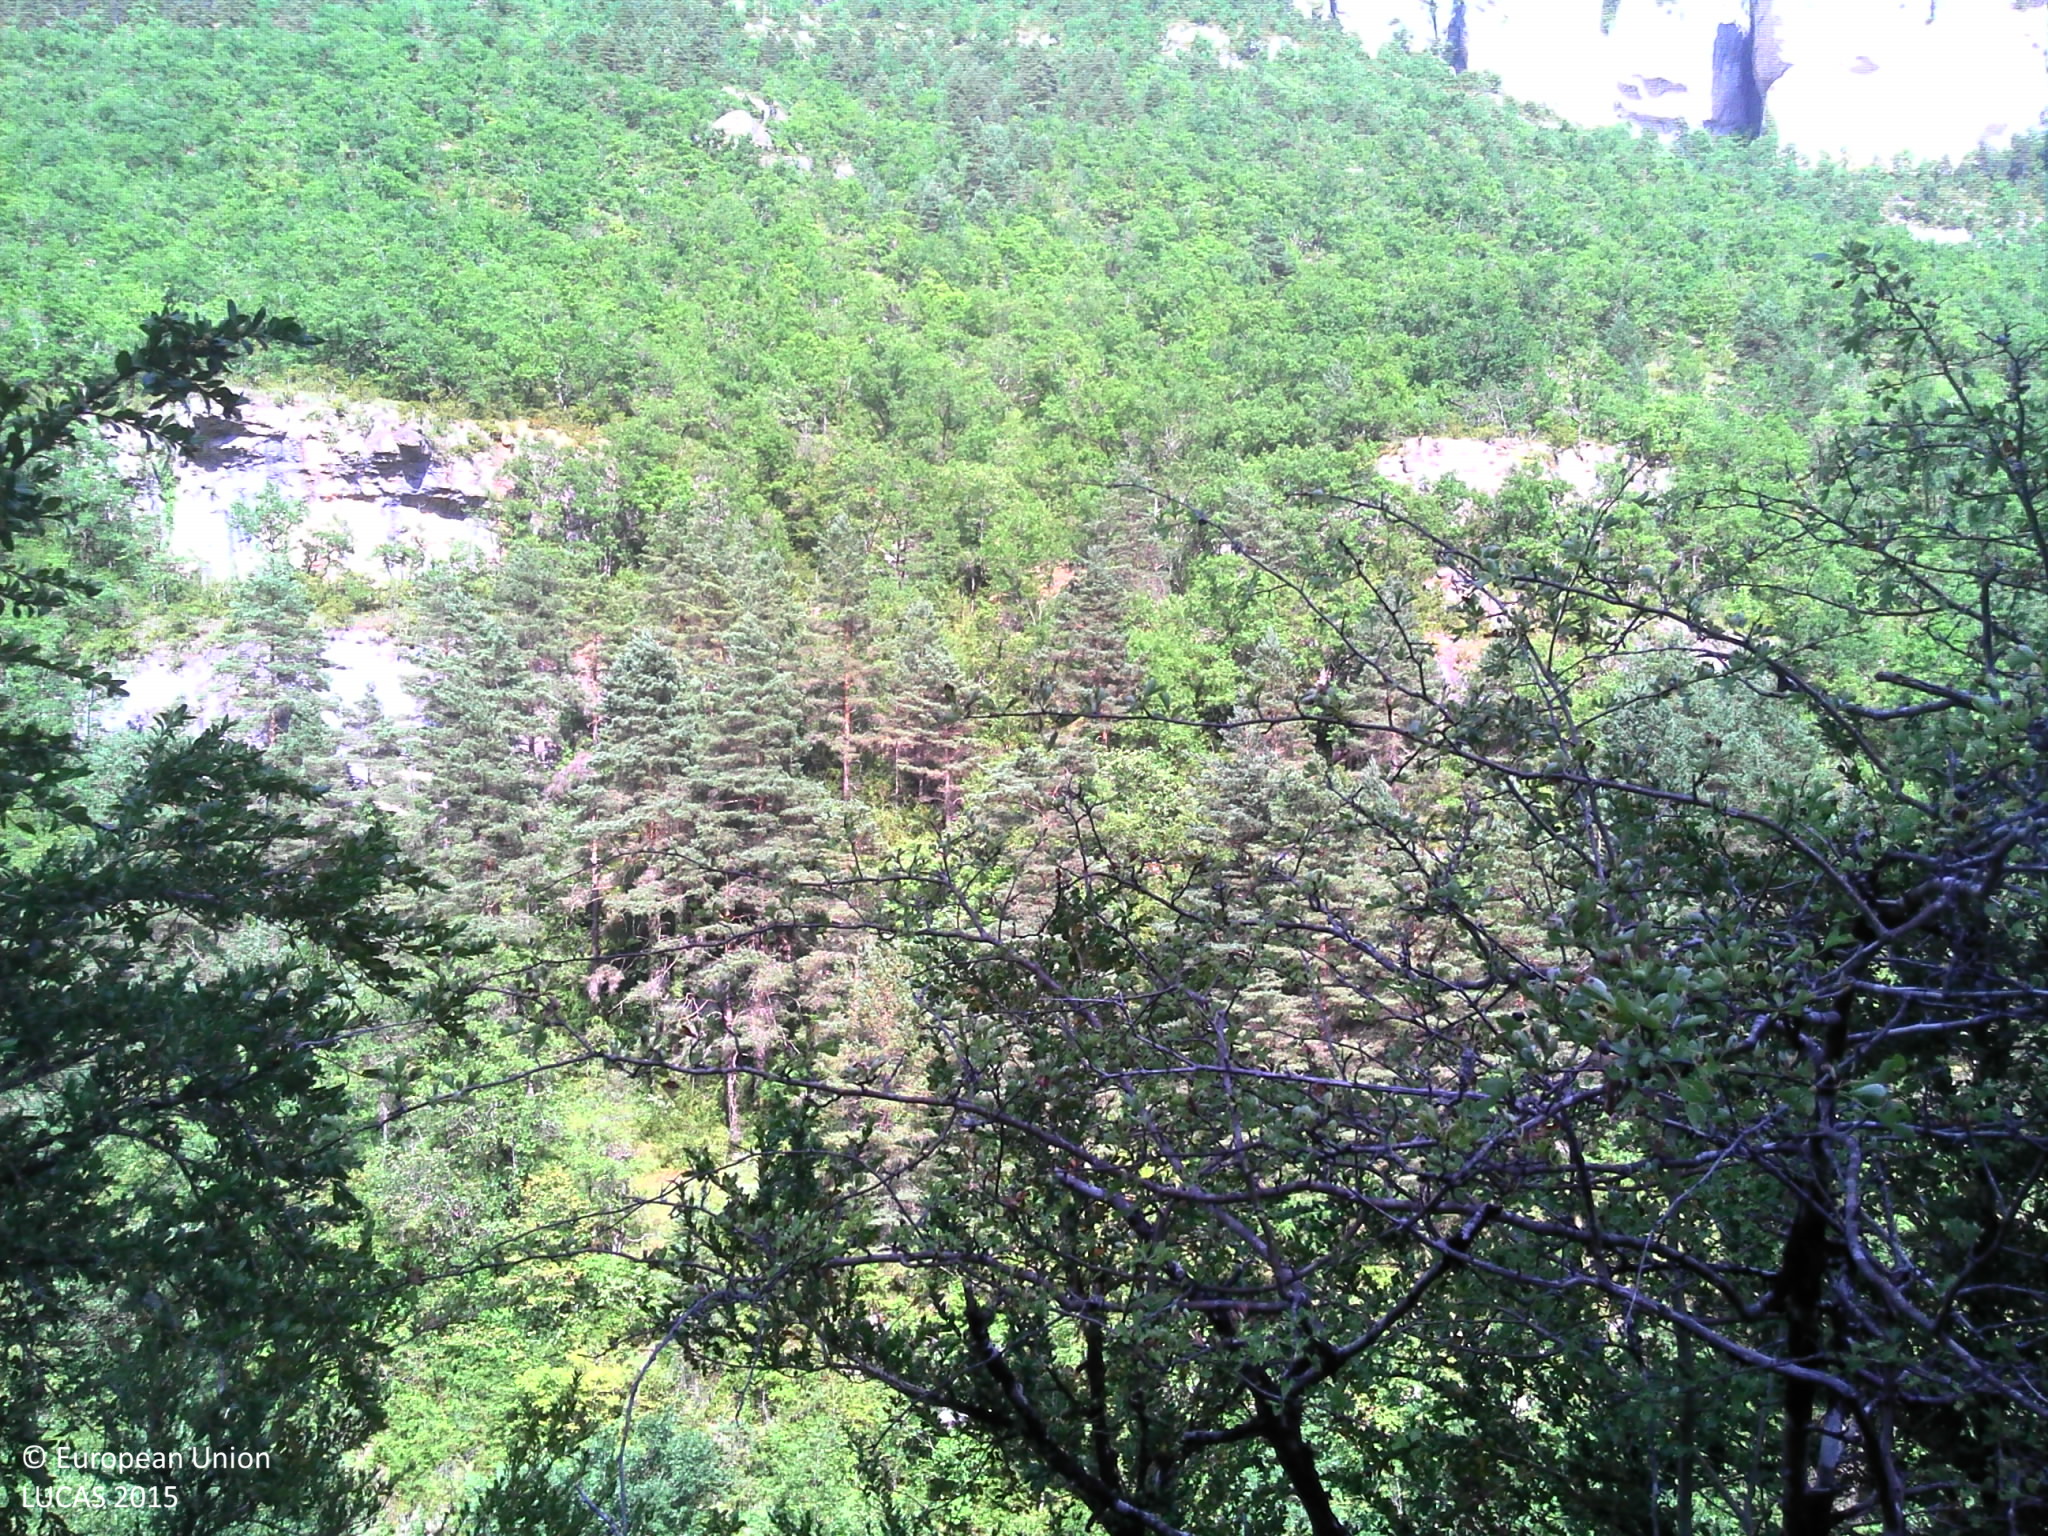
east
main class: Woodland
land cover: Pine dominated mixed woodland
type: hemiboreal forest and nemoral coniferous forest and mixed broadleaved-coniferous forest
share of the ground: > 75 %
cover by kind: broadleaved forest trees 75 %, coniferous forest trees 25 %
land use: Forestry
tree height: > 5 m
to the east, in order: Pine dominated mixed woodland
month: July
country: FR
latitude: 44.2381
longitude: 3.2318
